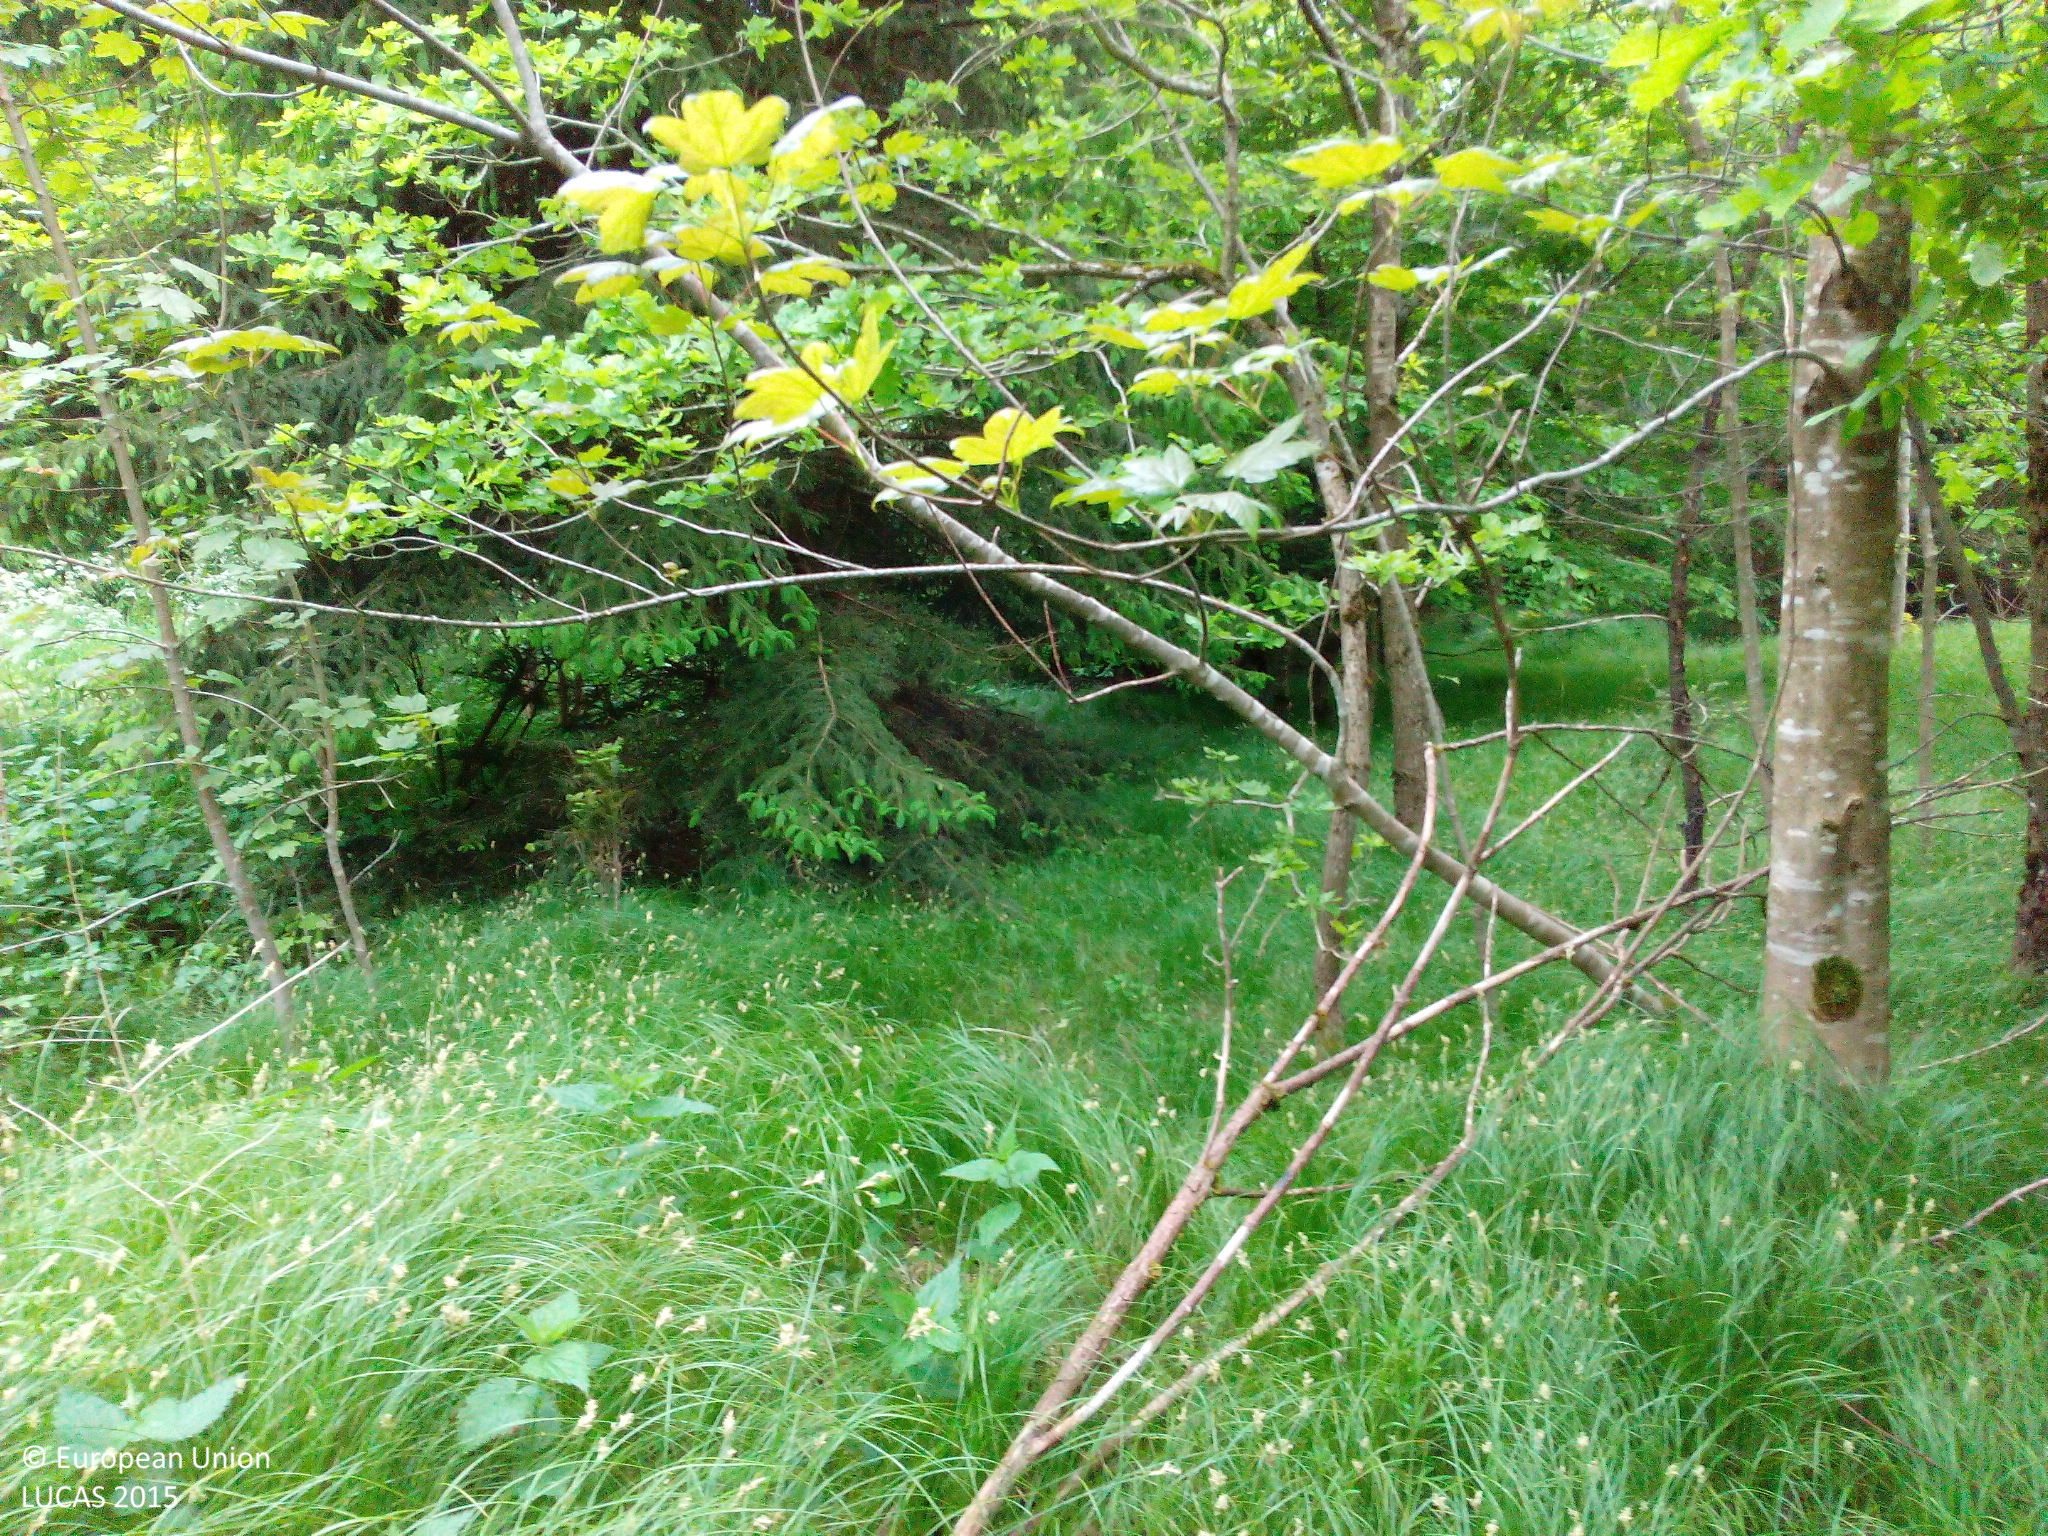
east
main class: Woodland
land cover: Broadleaved woodland
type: mesophytic deciduous forest
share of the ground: > 75 %
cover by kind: broadleaved forest trees 75 %, herbaceous plants 20 %, coniferous forest trees 5 %
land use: Forestry
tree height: > 5 m
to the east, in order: Broadleaved woodland; Grass margins; Tracks; Grass margins; Broadleaved woodland; Grass margins; Tracks; Grass margins; Spruce dominated coniferous woodland
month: May
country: DE
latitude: 48.0436
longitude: 9.9330
